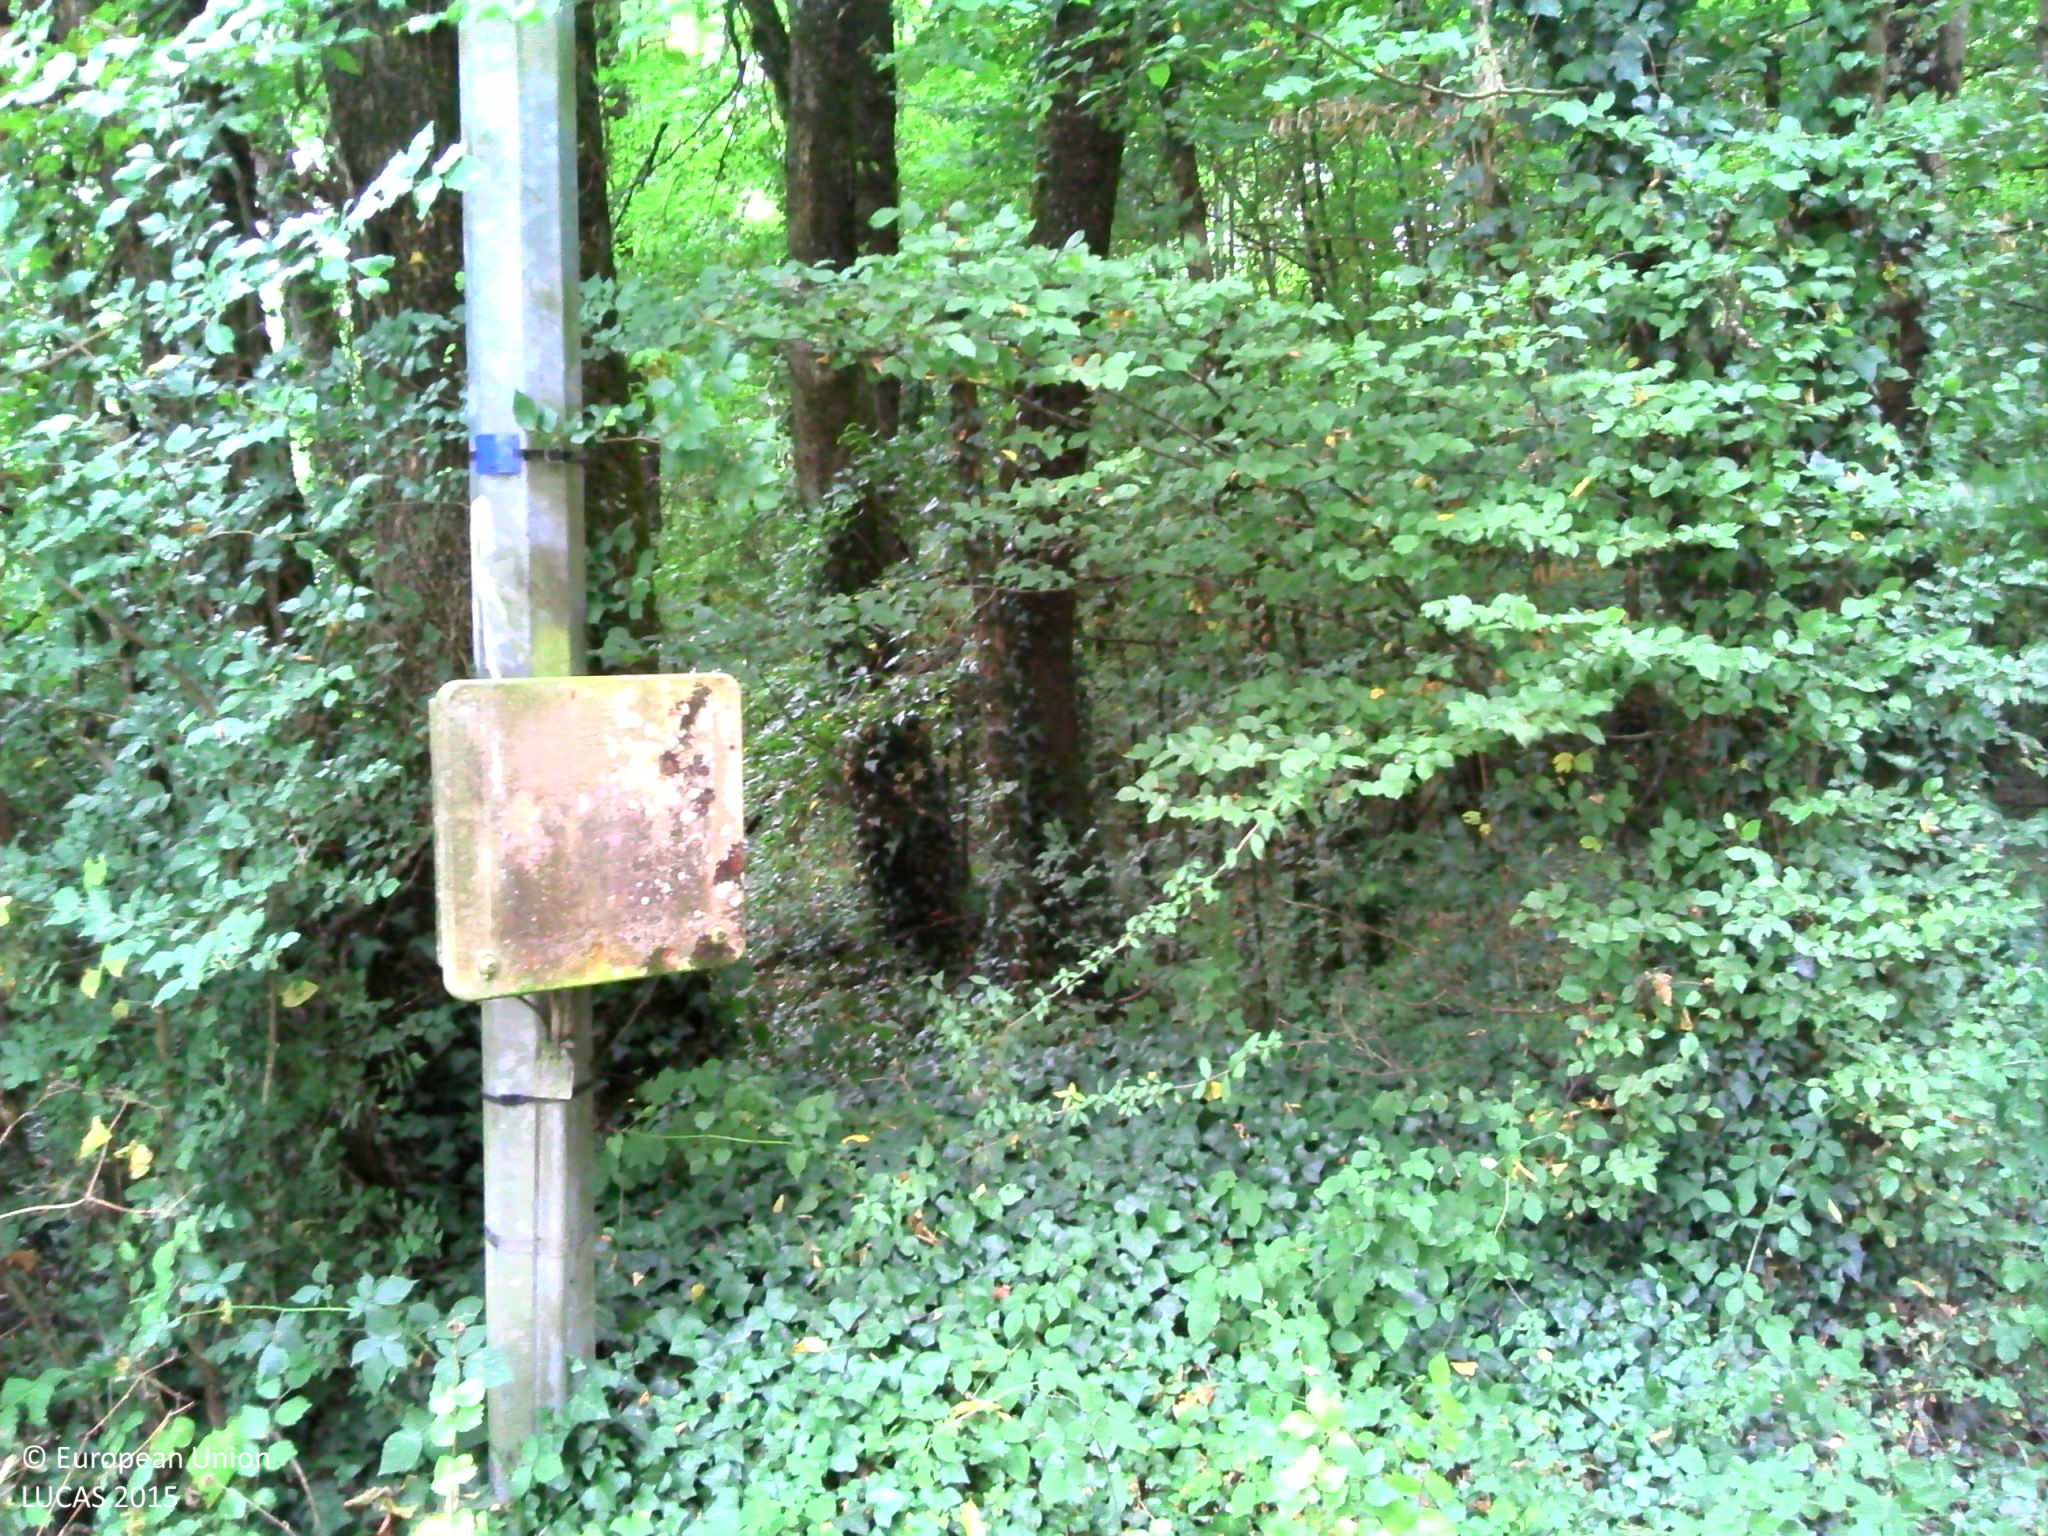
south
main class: Woodland
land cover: Broadleaved woodland
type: mesophytic deciduous forest
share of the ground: > 75 %
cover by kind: broadleaved forest trees 100 %
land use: Forestry
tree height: > 5 m
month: July
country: FR
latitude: 46.3828
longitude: 0.3208
